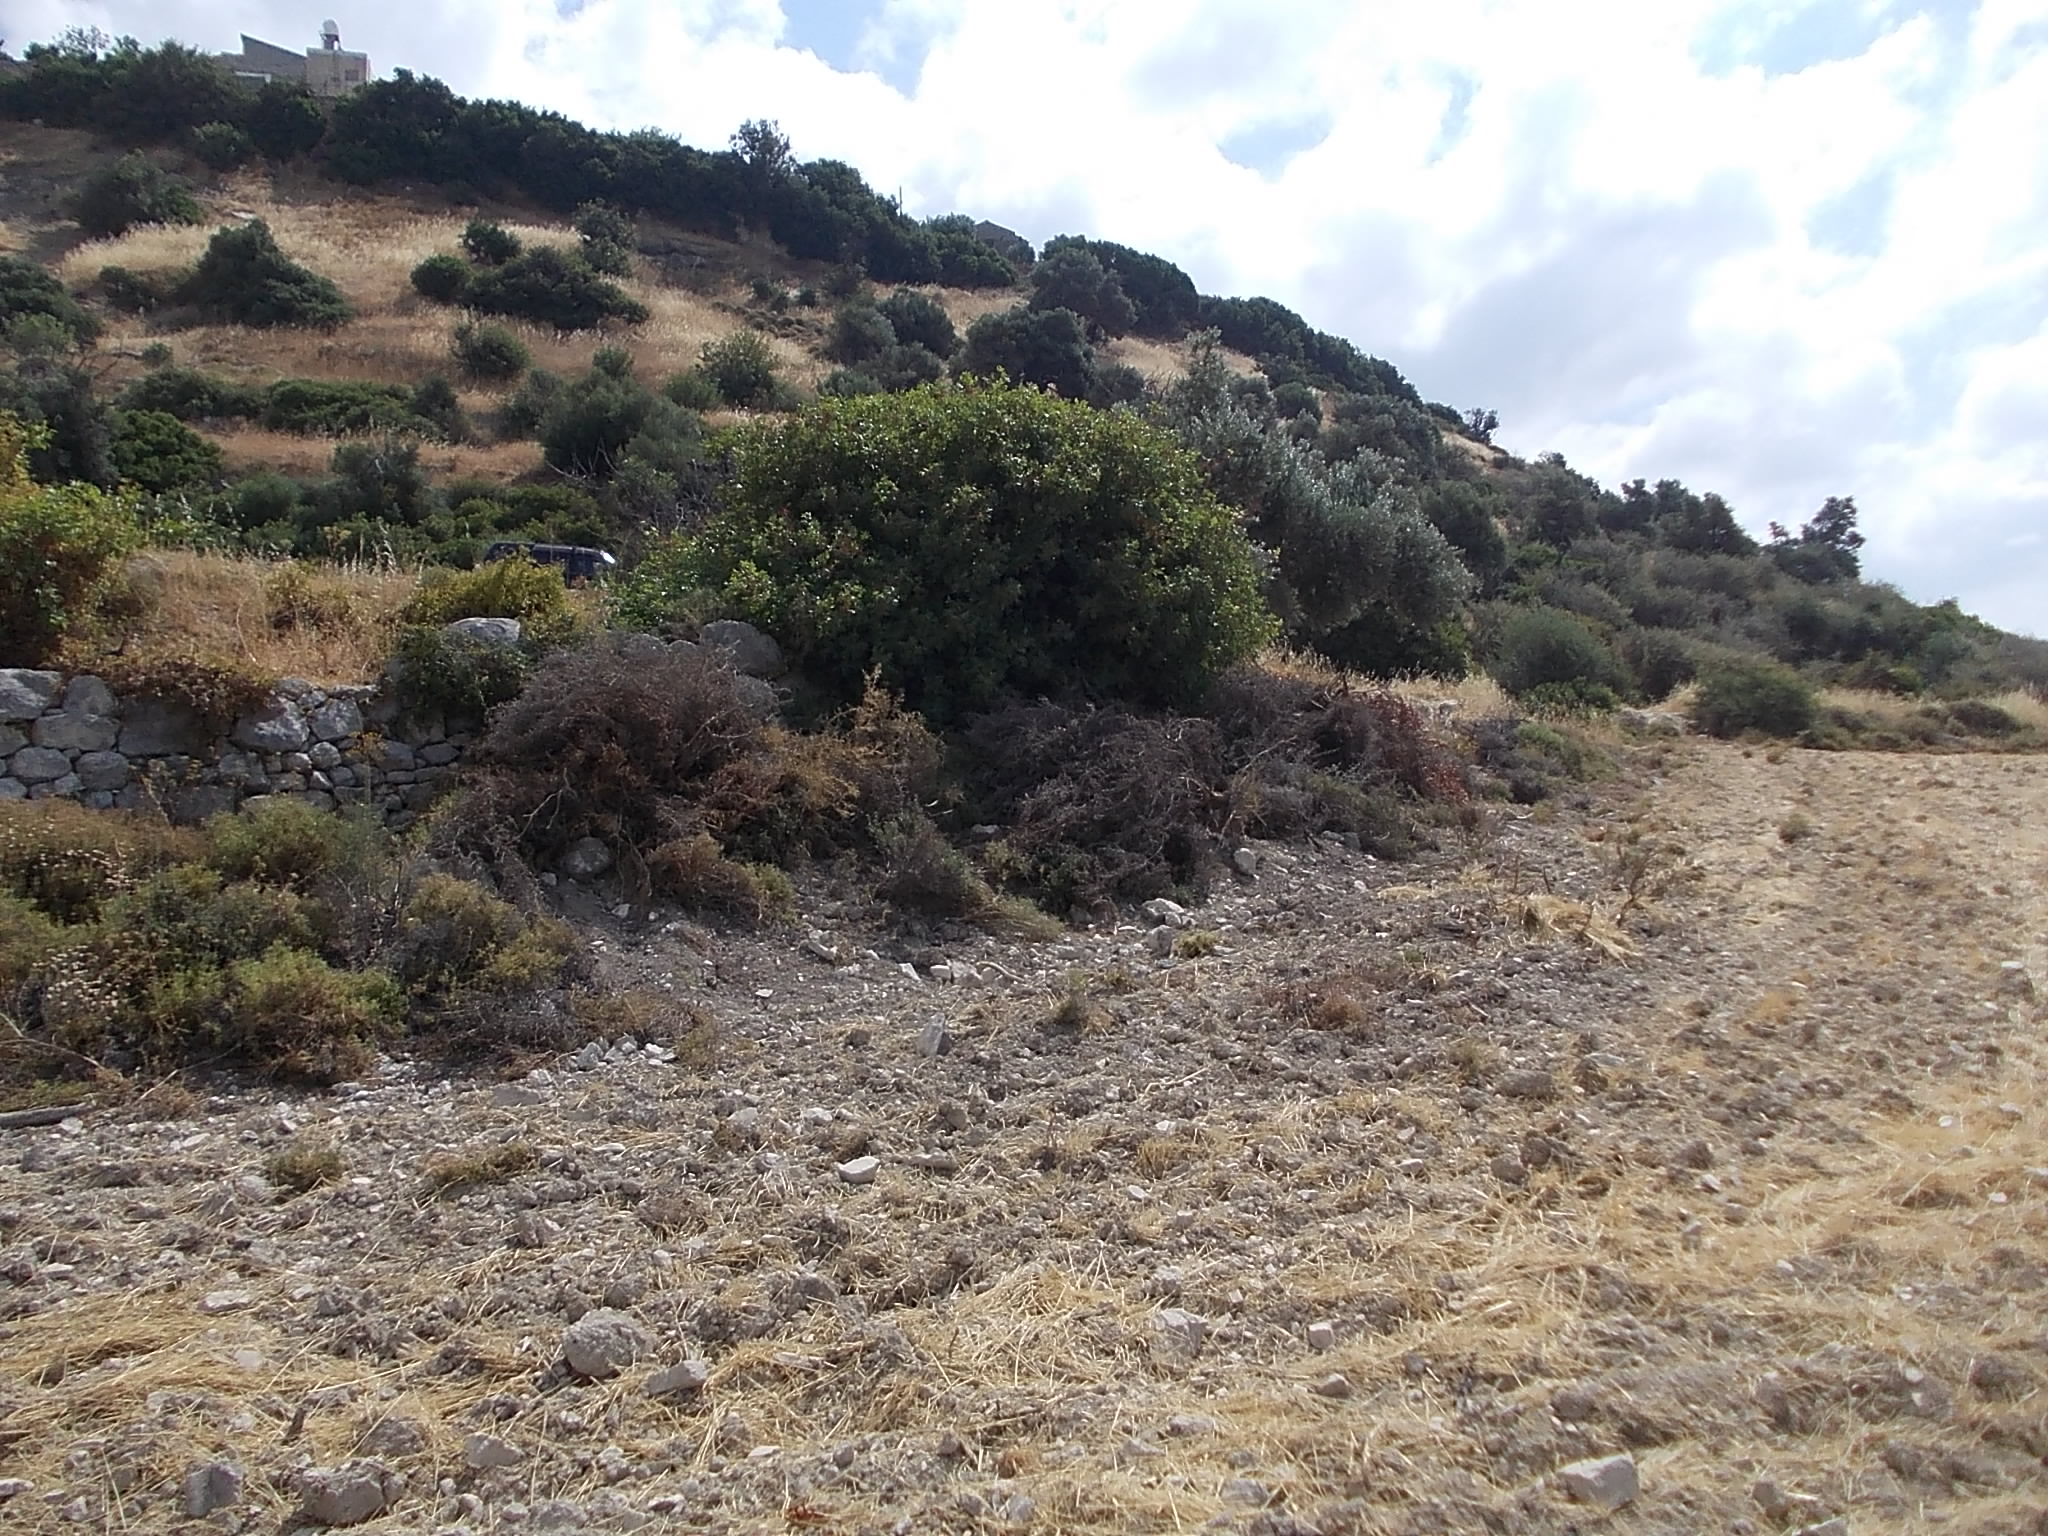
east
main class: Shrubland
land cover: Shrubland without tree cover
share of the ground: 25 - 50 %
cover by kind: shrubs 40 %, herbaceous plants 30 %, unconsolidated bare surface 30 %
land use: Semi-natural and natural areas not in use
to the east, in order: Shrubland without tree cover; Other bare soil; Shrubland with sparse tree cover; Dry stone walls; Shrubland with sparse tree cover; Paved roads, cycling and walking lanes; Shrubland with sparse tree cover; Dry stone walls; Shrubland with sparse tree cover; Shrubland without tree cover; Shrubland with sparse tree cover
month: June
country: CY
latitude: 34.7144
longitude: 32.7232
